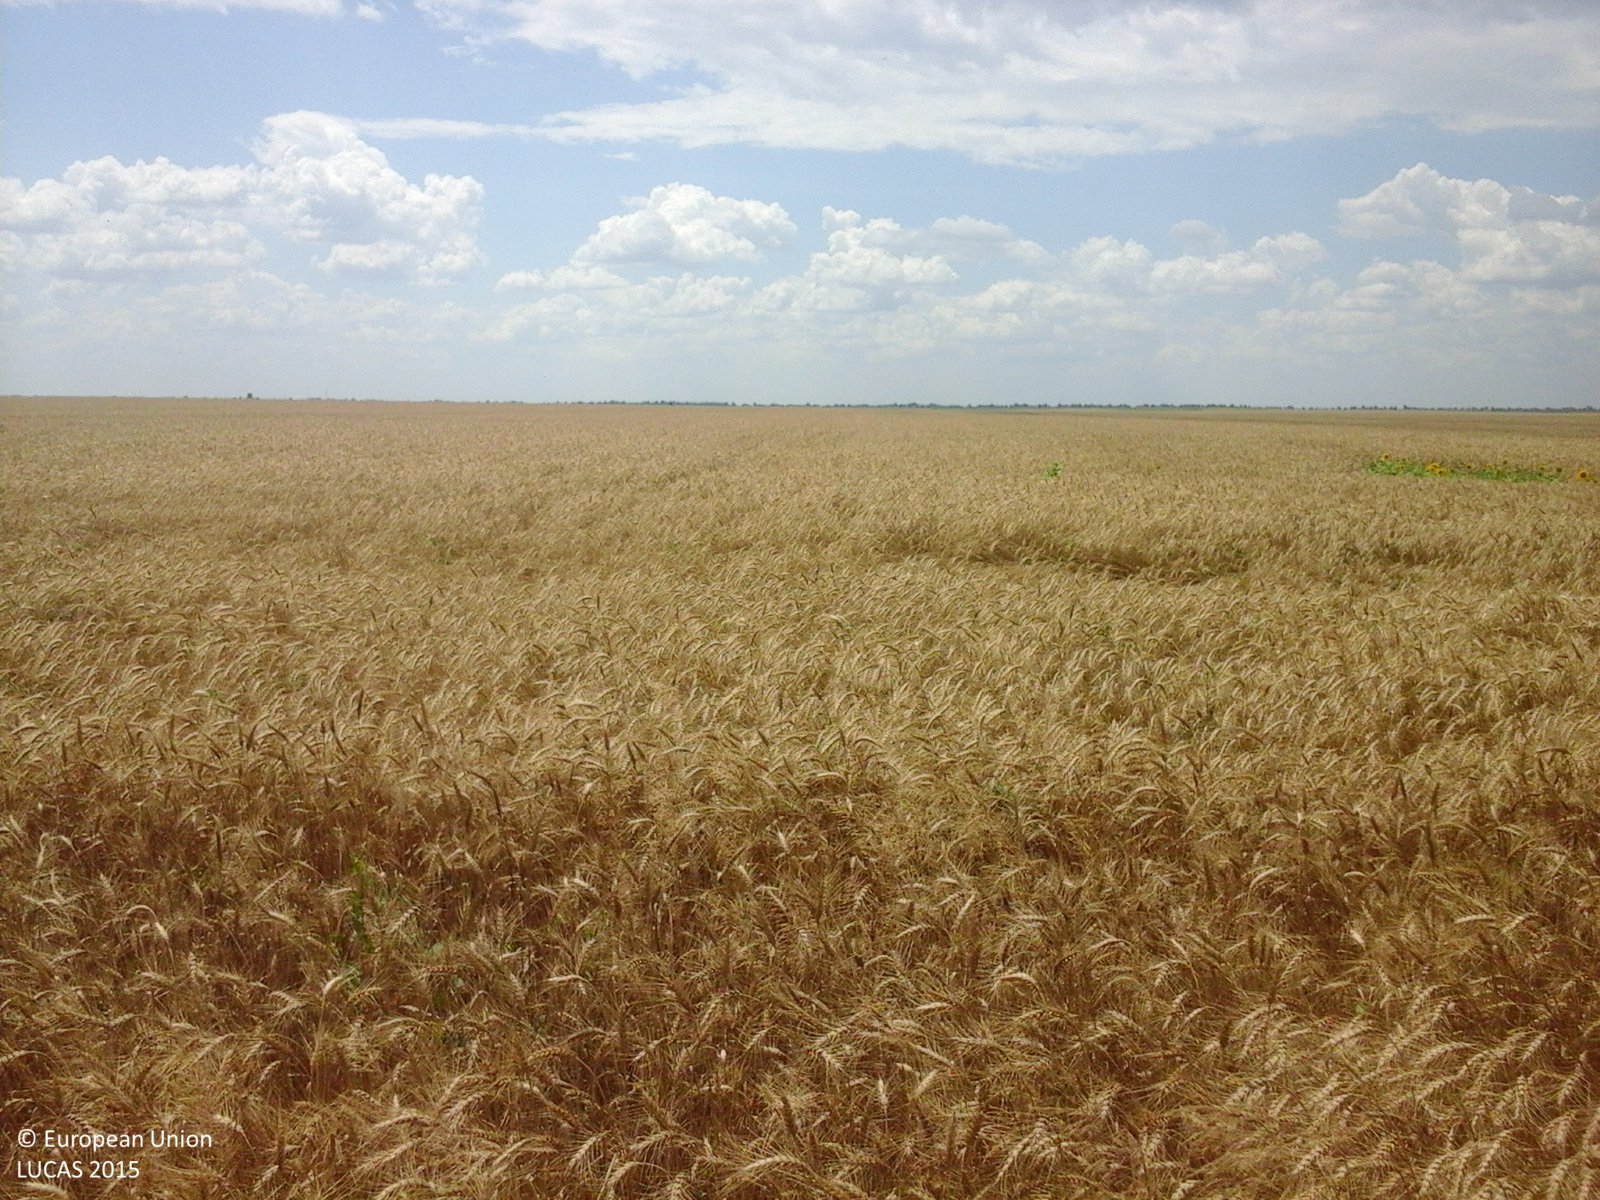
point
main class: Cropland
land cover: Common wheat
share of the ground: > 75 %
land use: Agriculture (excluding fallow land and kitchen gardens)
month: July
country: RO
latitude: 44.0284
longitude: 24.7060
